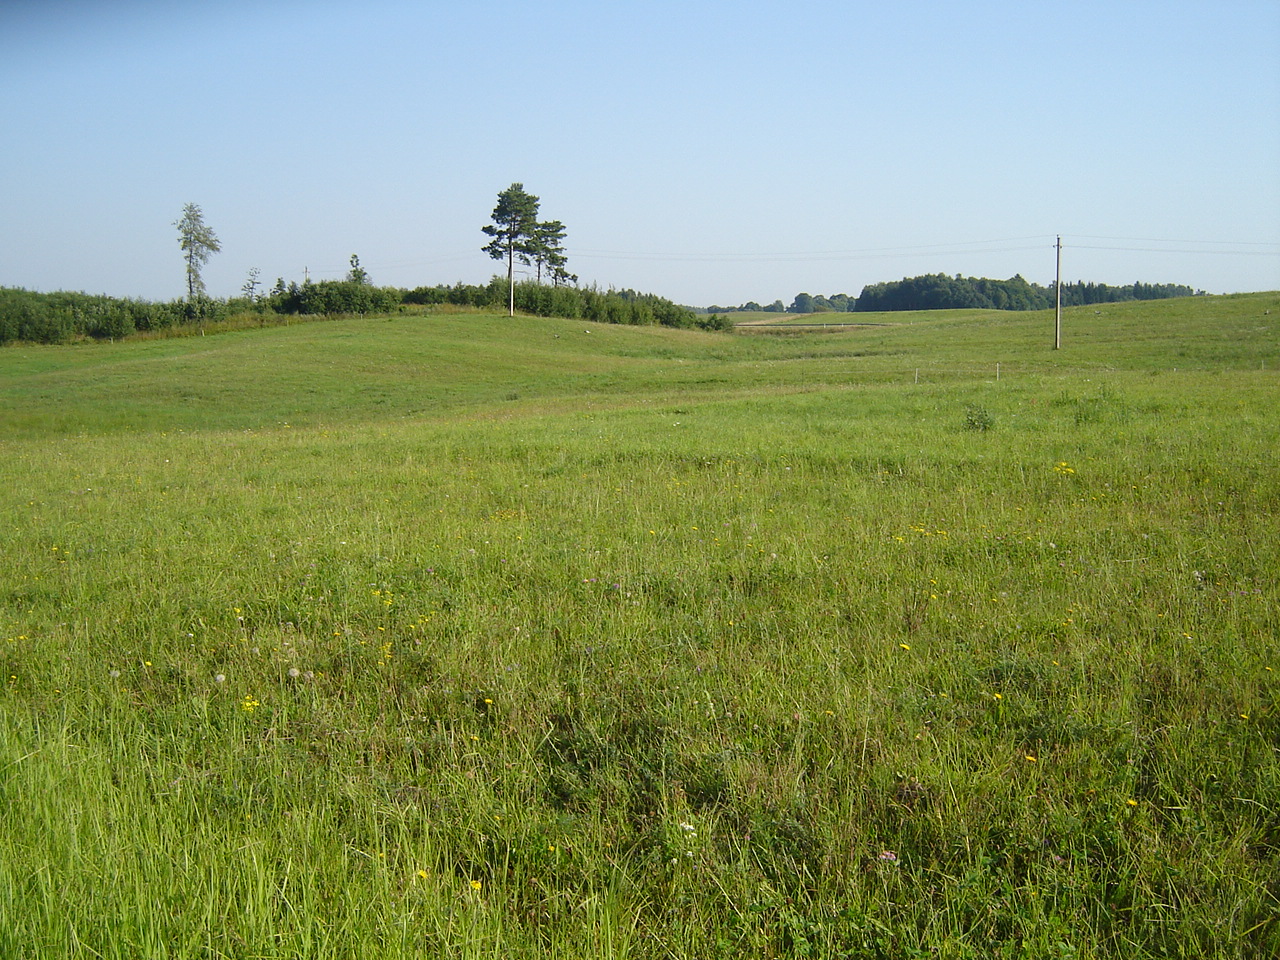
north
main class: Grassland
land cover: Grassland without tree/shrub cover
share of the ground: > 75 %
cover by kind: herbaceous plants 100 %
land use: Agriculture (excluding fallow land and kitchen gardens)
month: August
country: LT
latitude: 55.1891
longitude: 25.1482
